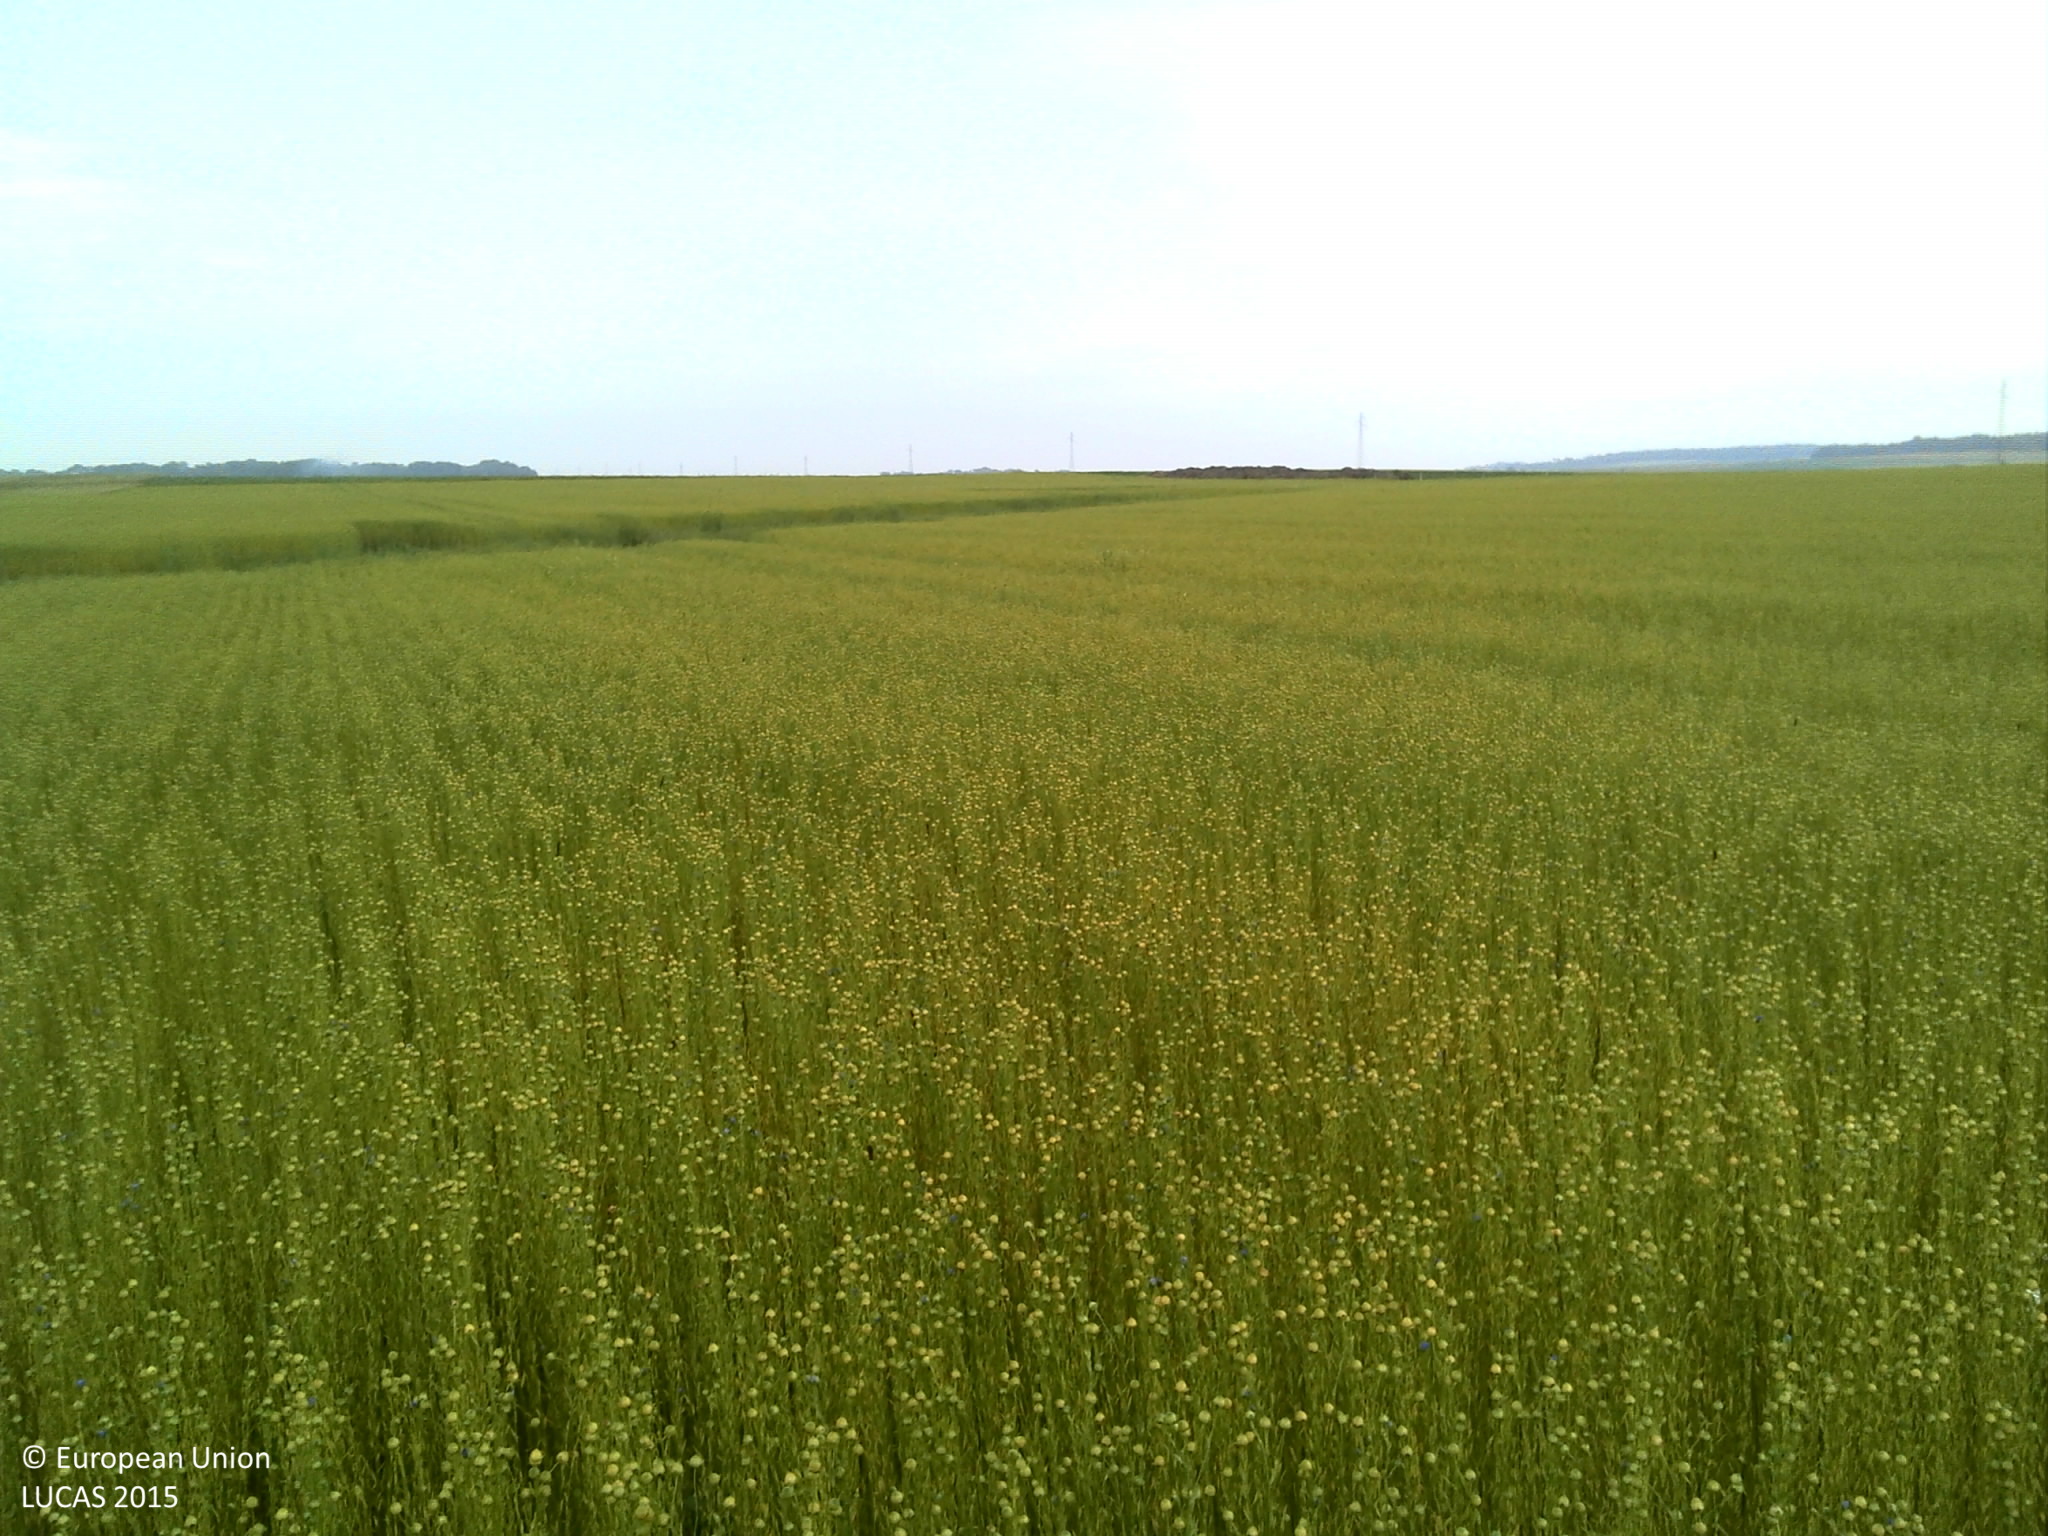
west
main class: Cropland
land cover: Other fibre and oleaginous crops
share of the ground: > 75 %
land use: Agriculture (excluding fallow land and kitchen gardens)
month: July
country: FR
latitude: 49.8843
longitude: 1.0285
